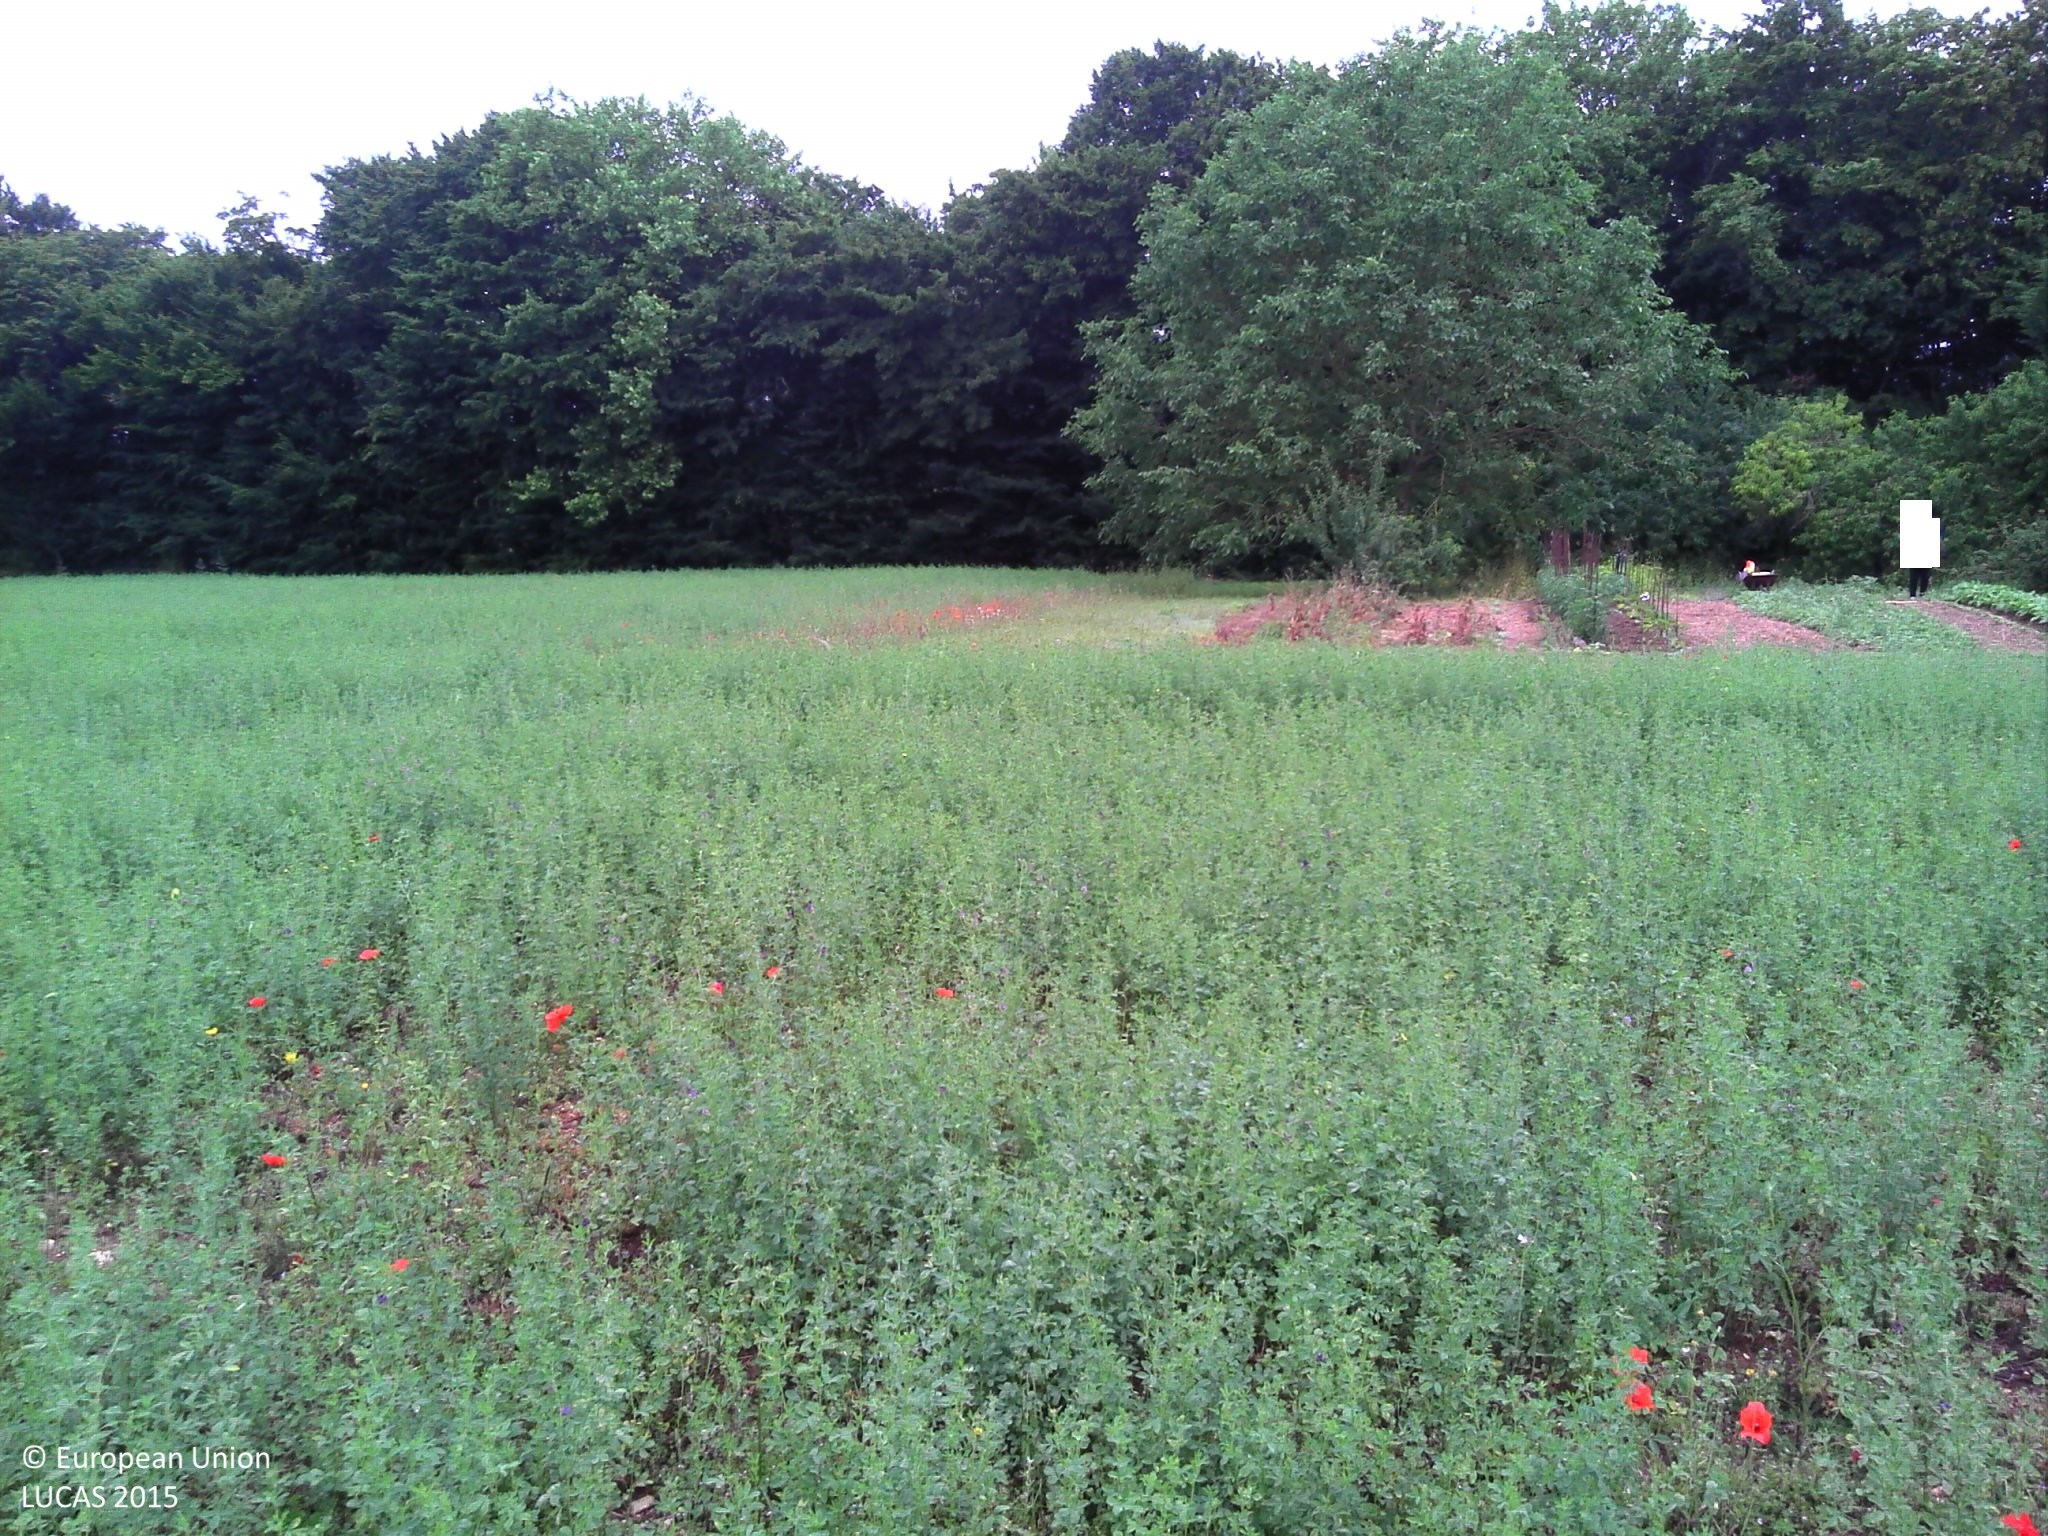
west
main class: Cropland
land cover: Lucerne
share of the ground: > 75 %
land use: Agriculture (excluding fallow land and kitchen gardens)
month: June
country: FR
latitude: 46.5596
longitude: 0.4727
